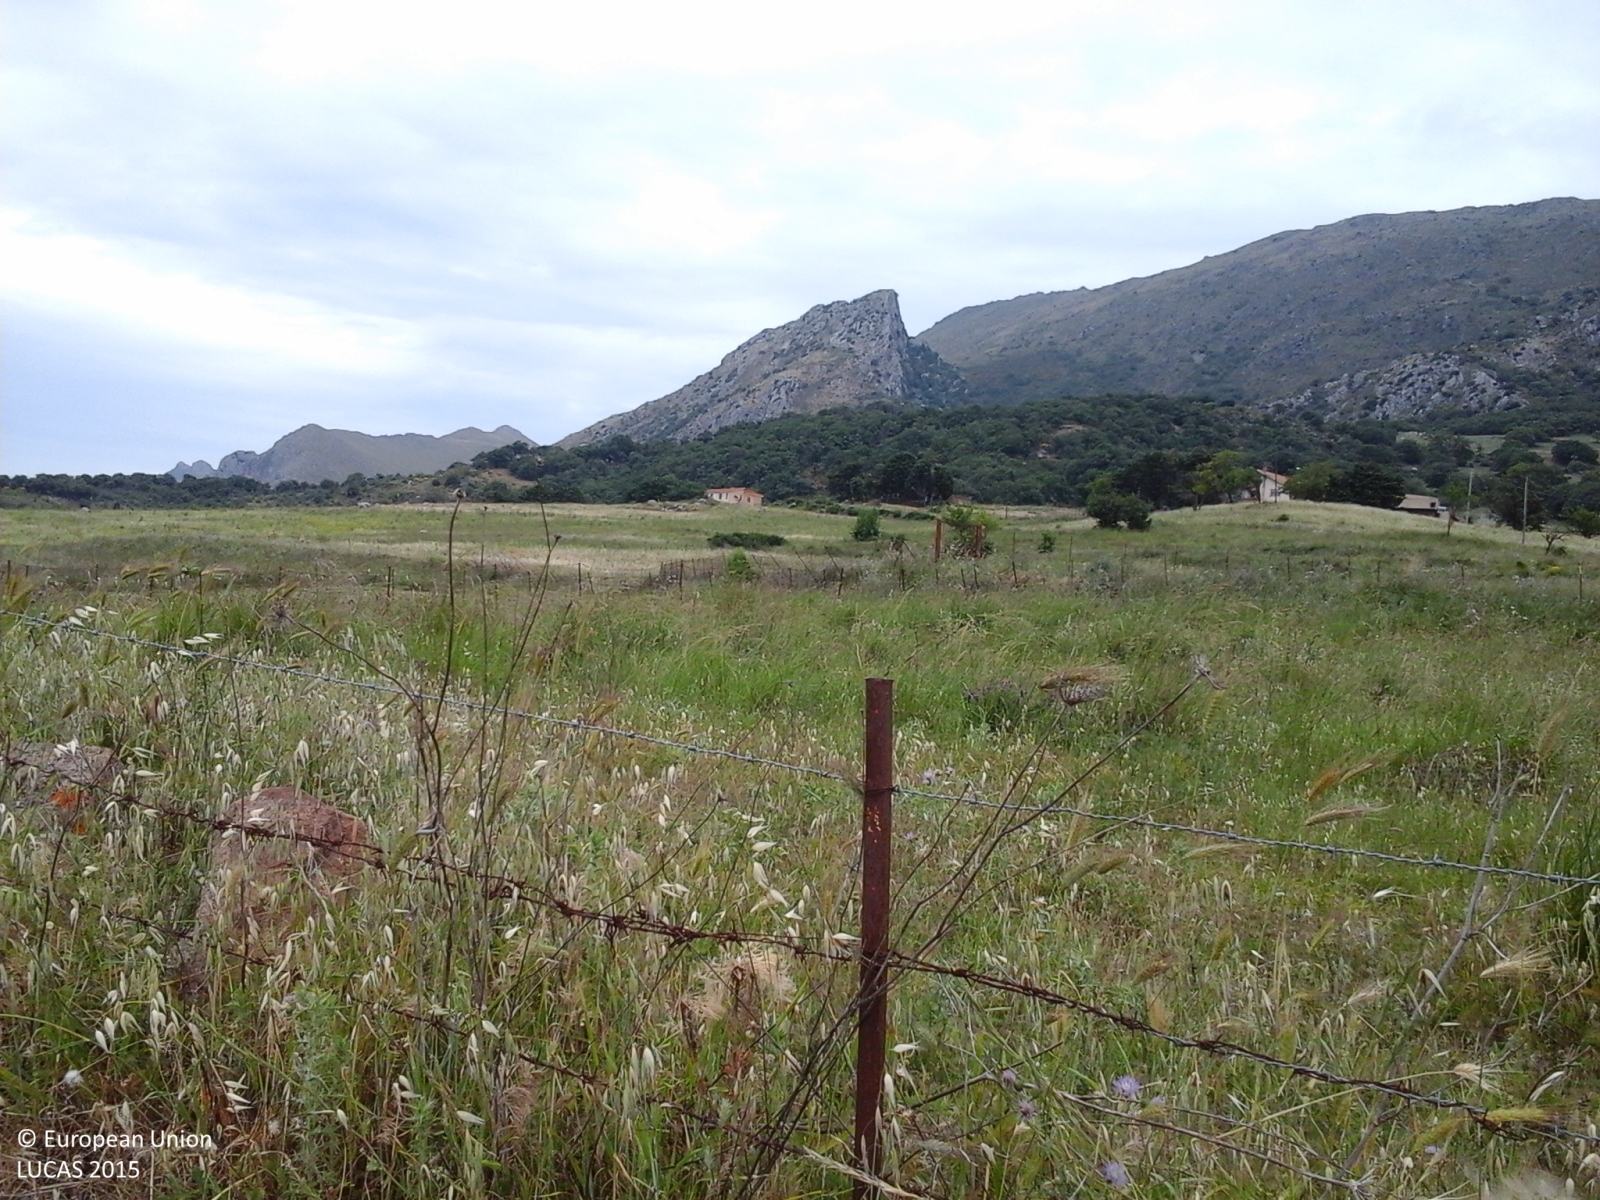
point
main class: Cropland
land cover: Other leguminous and mixtures for fodder
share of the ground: > 75 %
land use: Agriculture (excluding fallow land and kitchen gardens)
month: May
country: IT
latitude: 37.9353
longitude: 13.5587
